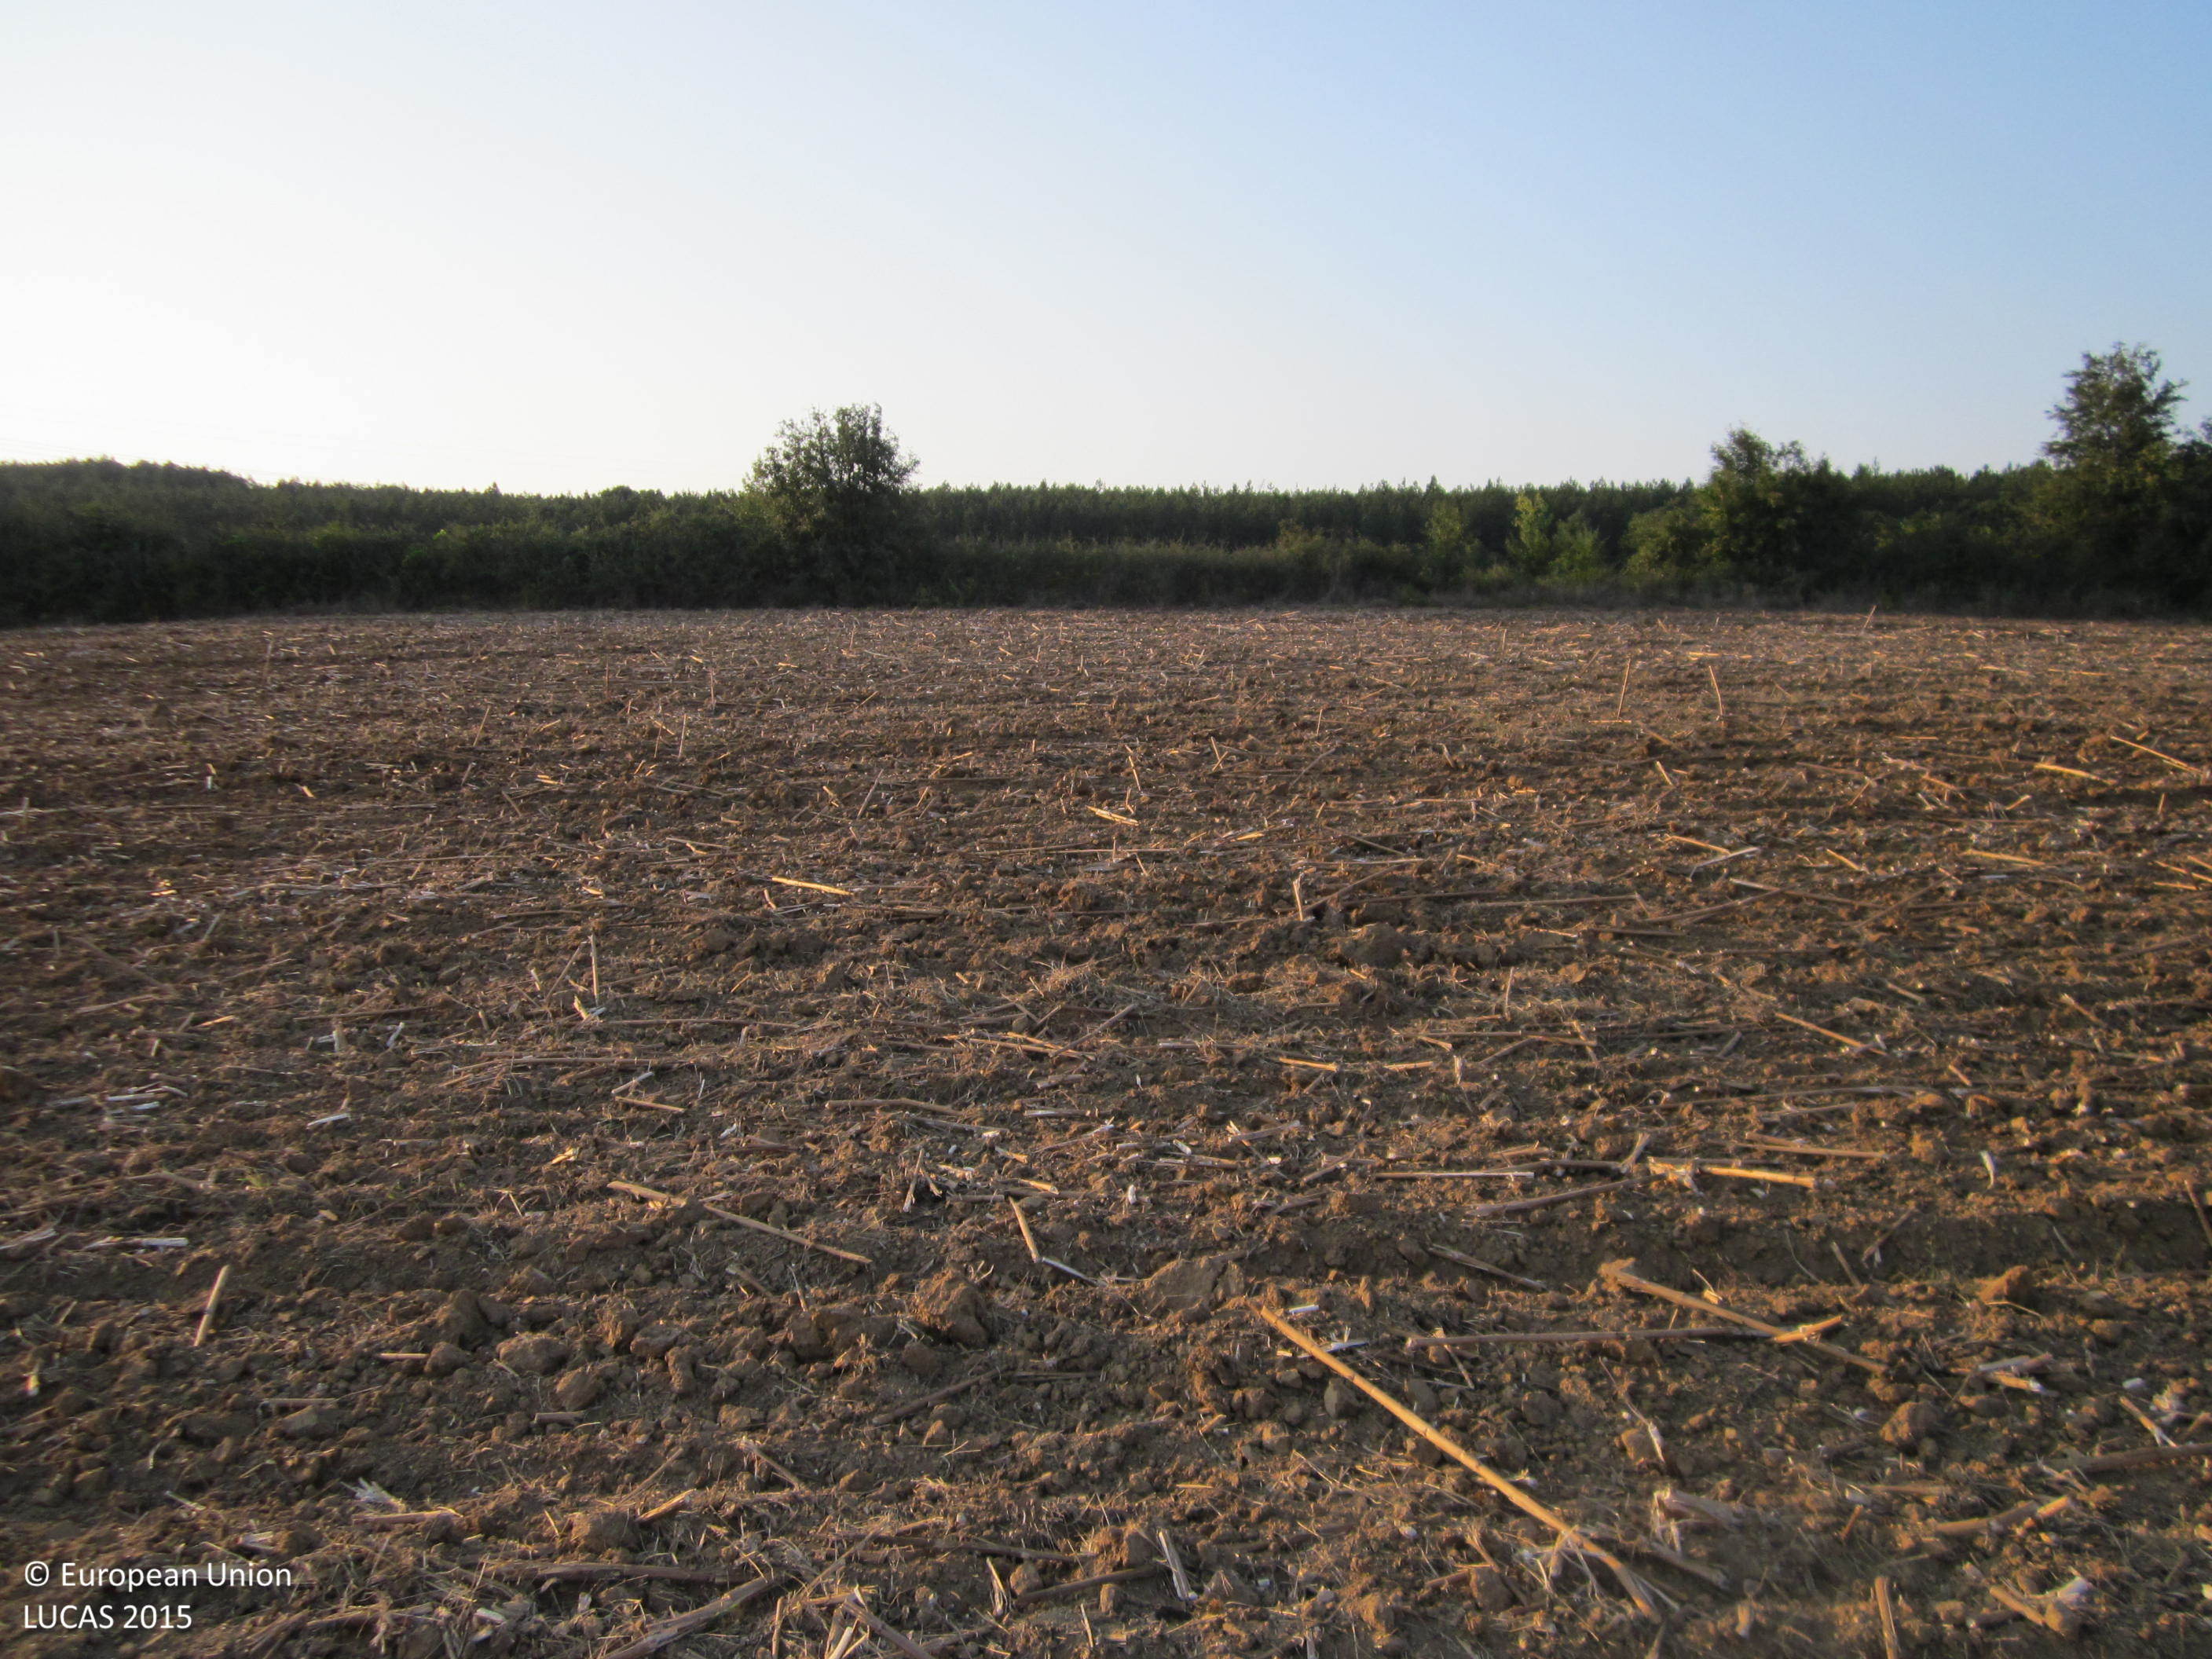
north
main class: Cropland
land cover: Sunflower
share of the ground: < 10 %
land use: Agriculture (excluding fallow land and kitchen gardens)
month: September
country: BG
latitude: 42.8258
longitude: 27.1022
